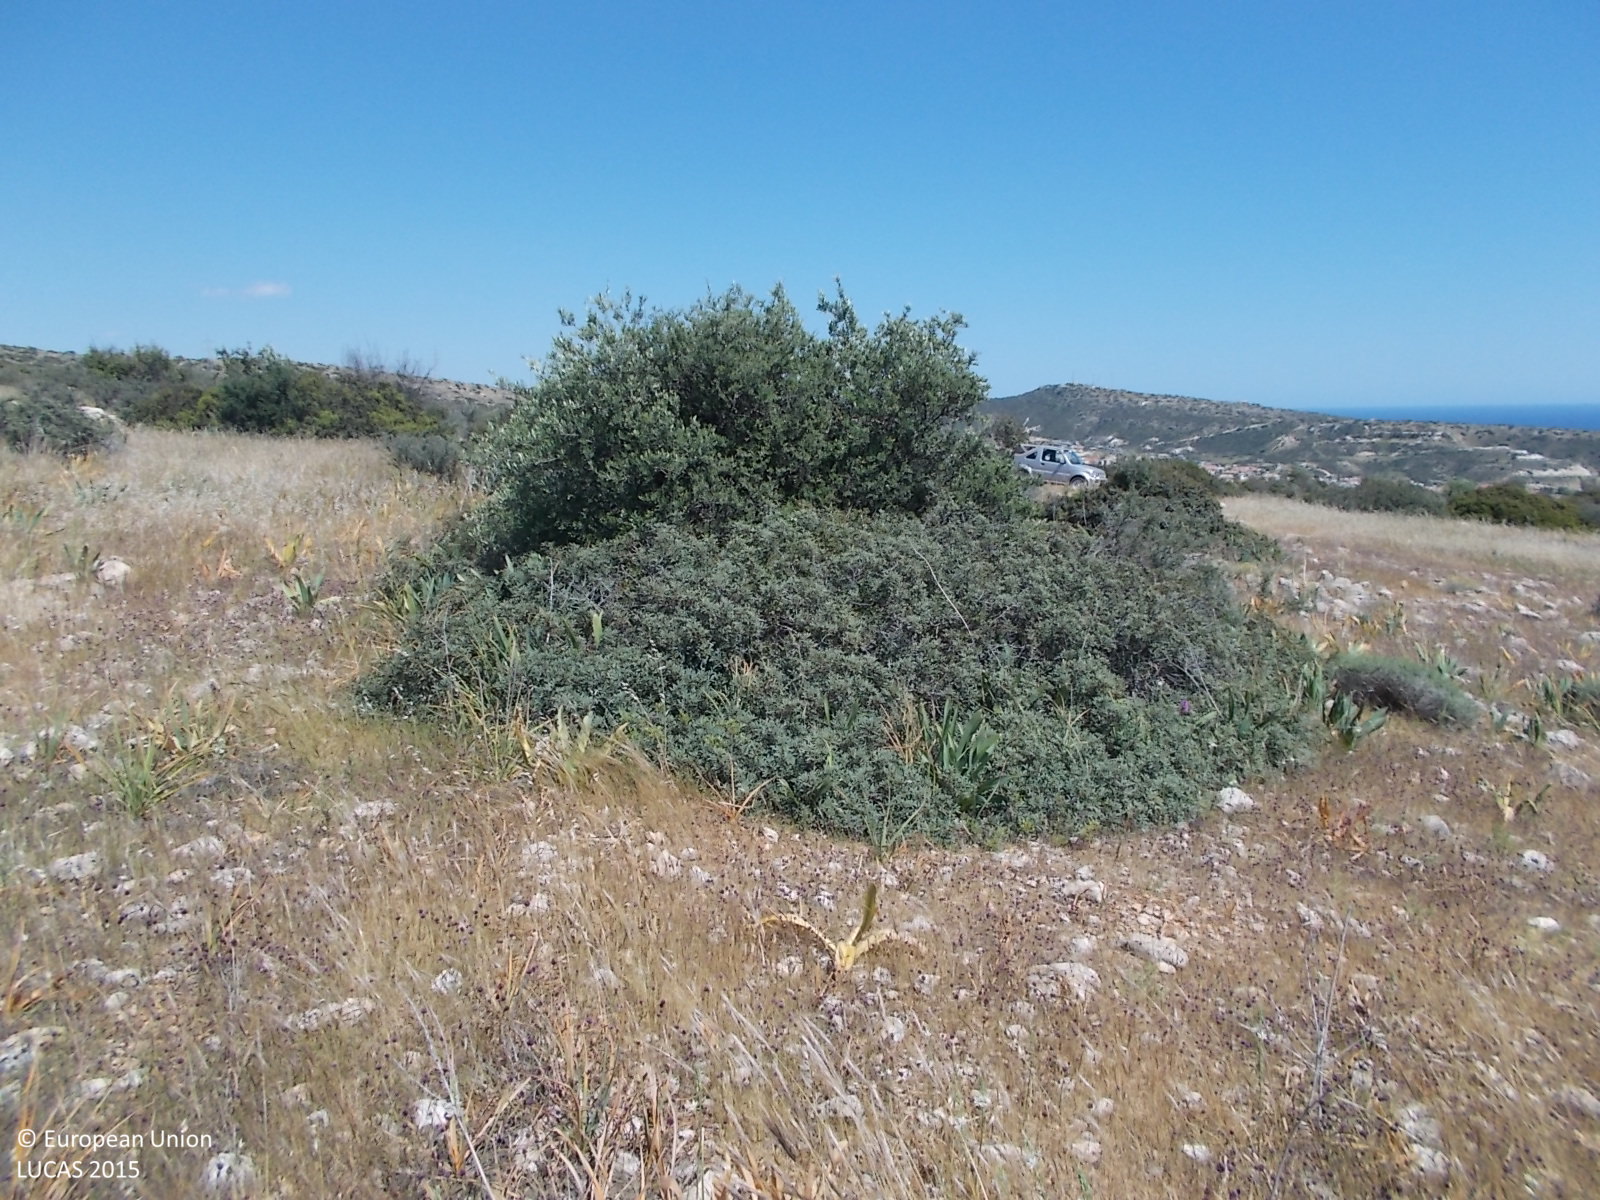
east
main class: Shrubland
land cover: Shrubland with sparse tree cover
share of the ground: 50 - 75 %
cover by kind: shrubs 65 %, herbaceous plants 20 %, broadleaved forest trees 5 %, consolidated bare surface 5 %, unconsolidated bare surface 5 %
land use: Semi-natural and natural areas not in use
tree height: < 5 m
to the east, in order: Shrubland with sparse tree cover; Tracks; Shrubland with sparse tree cover; Dry stone walls; Shrubland with sparse tree cover; Tracks; Shrubland with sparse tree cover; Tracks; Shrubland with sparse tree cover
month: April
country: CY
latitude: 34.7328
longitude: 33.0924
